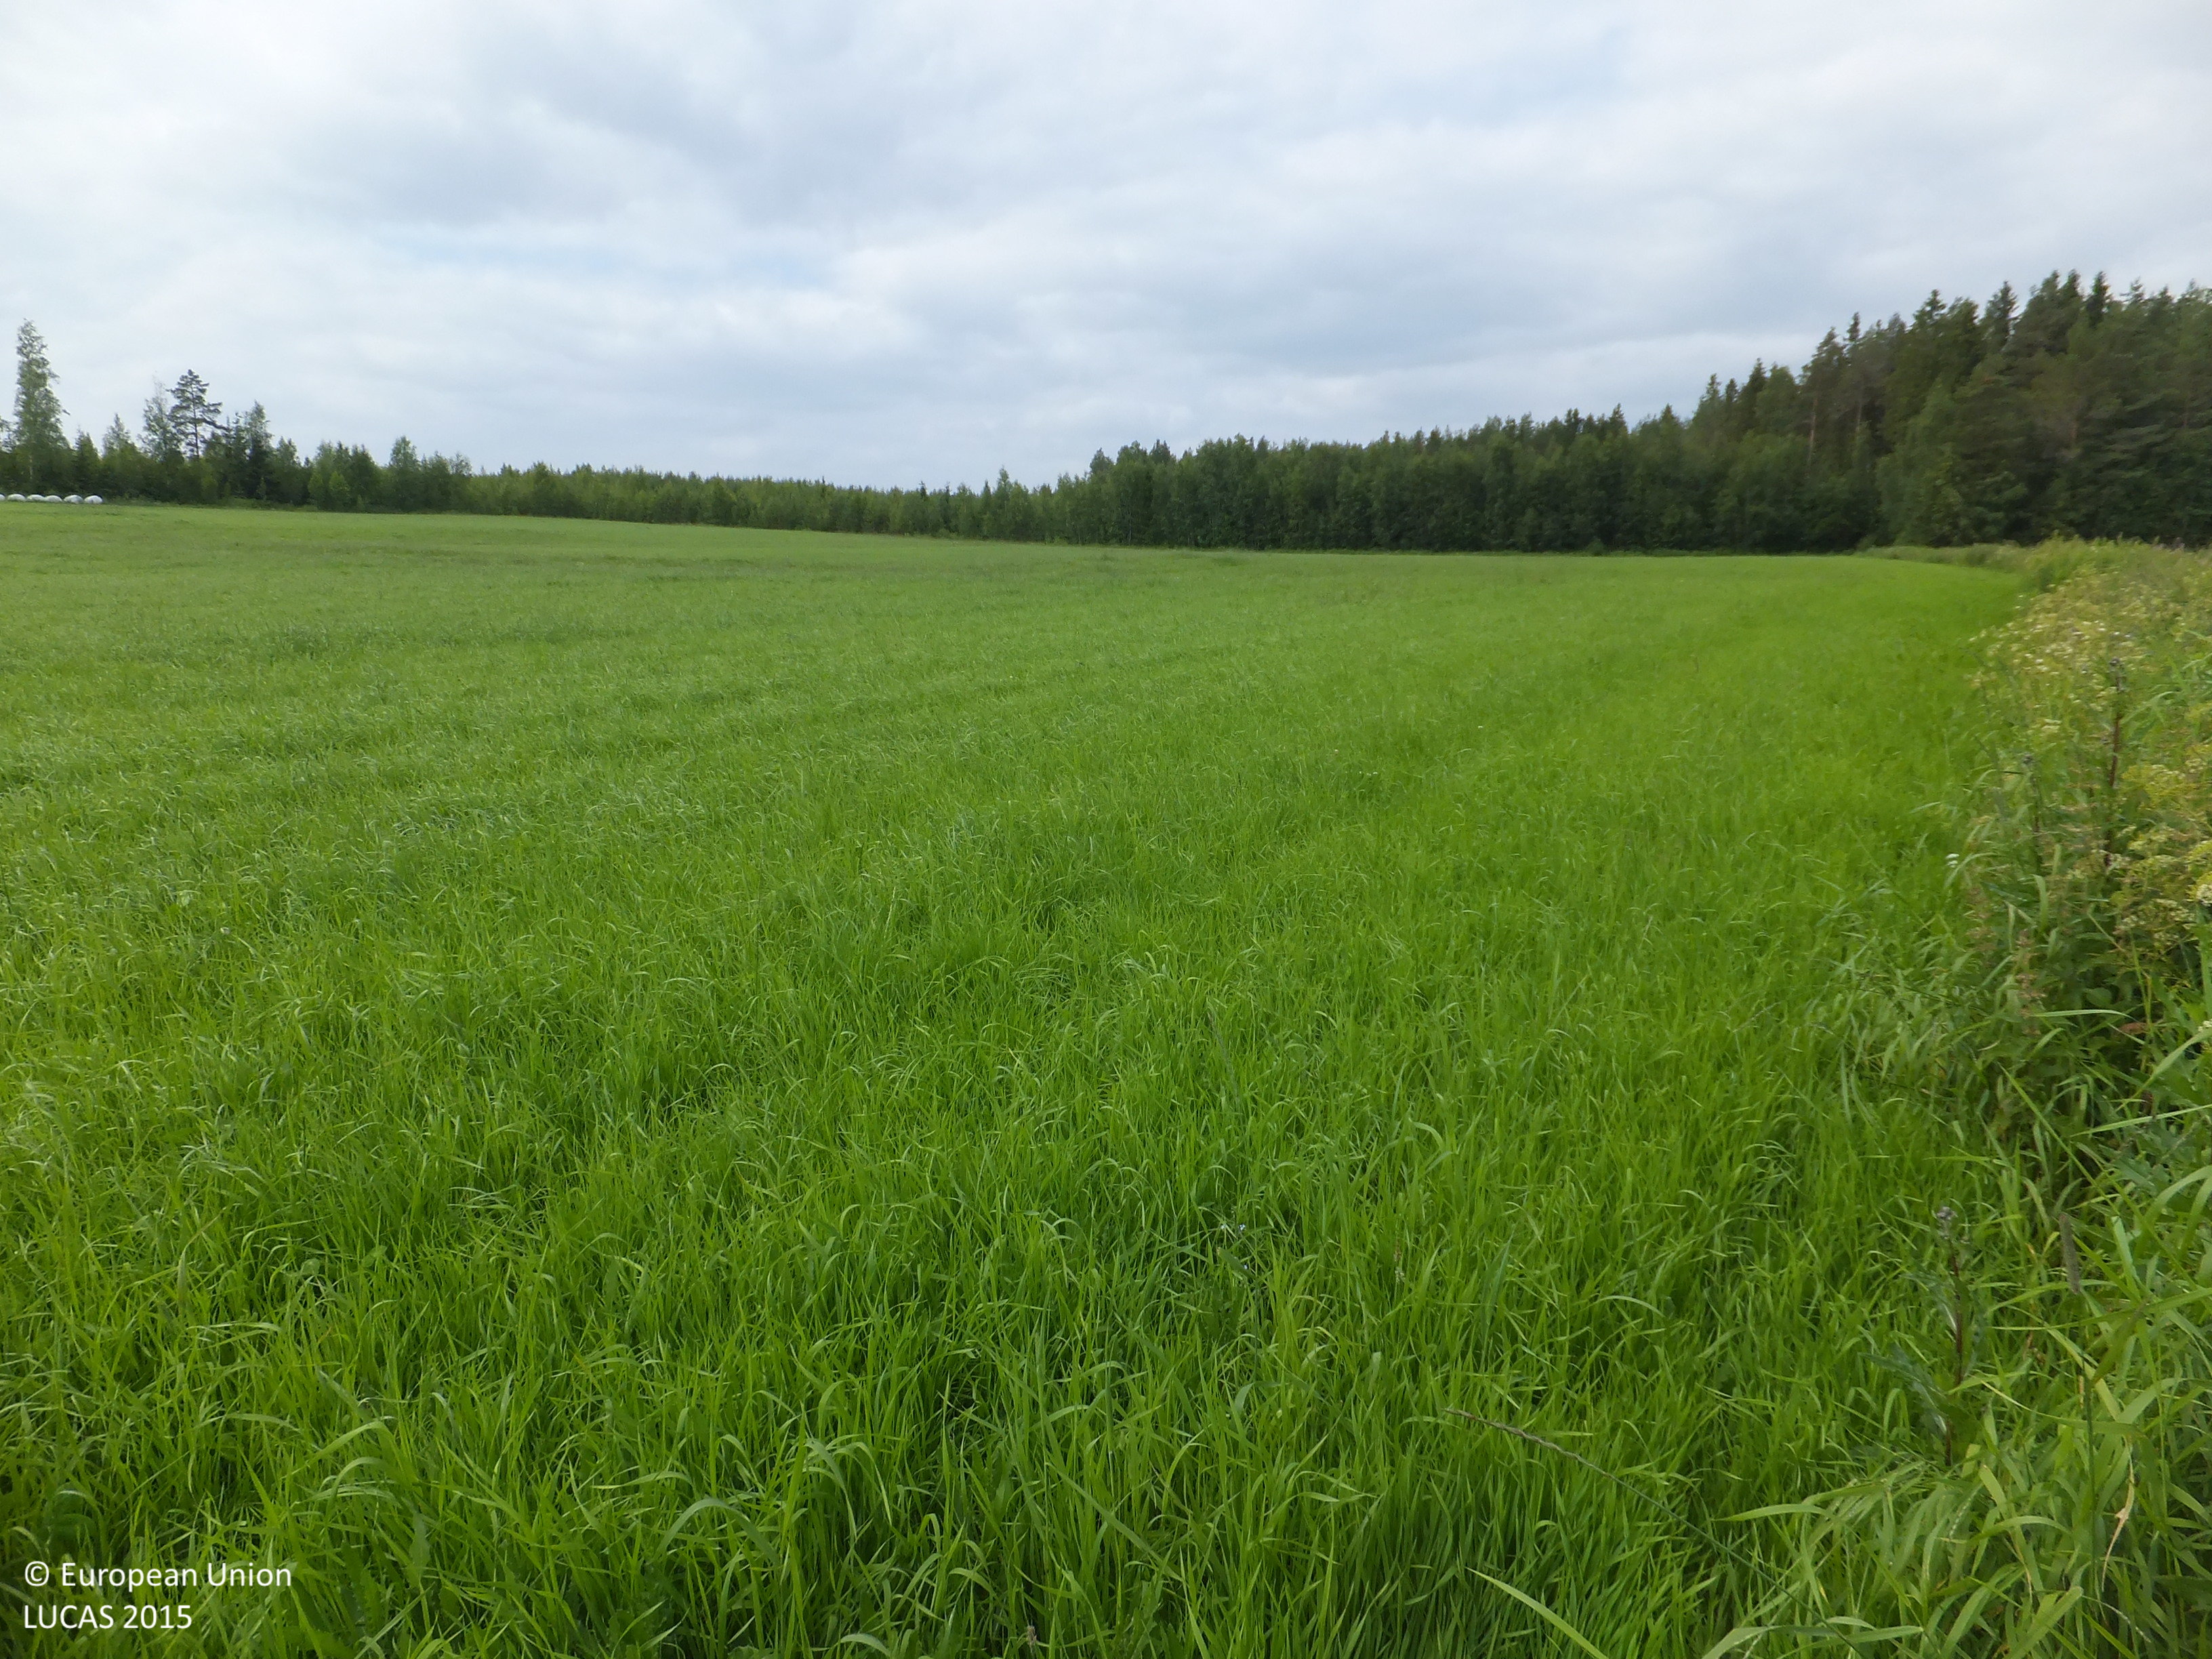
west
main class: Grassland
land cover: Grassland without tree/shrub cover
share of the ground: > 75 %
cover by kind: herbaceous plants 100 %
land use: Agriculture (excluding fallow land and kitchen gardens)
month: July
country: FI
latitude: 63.4755
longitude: 23.0000
